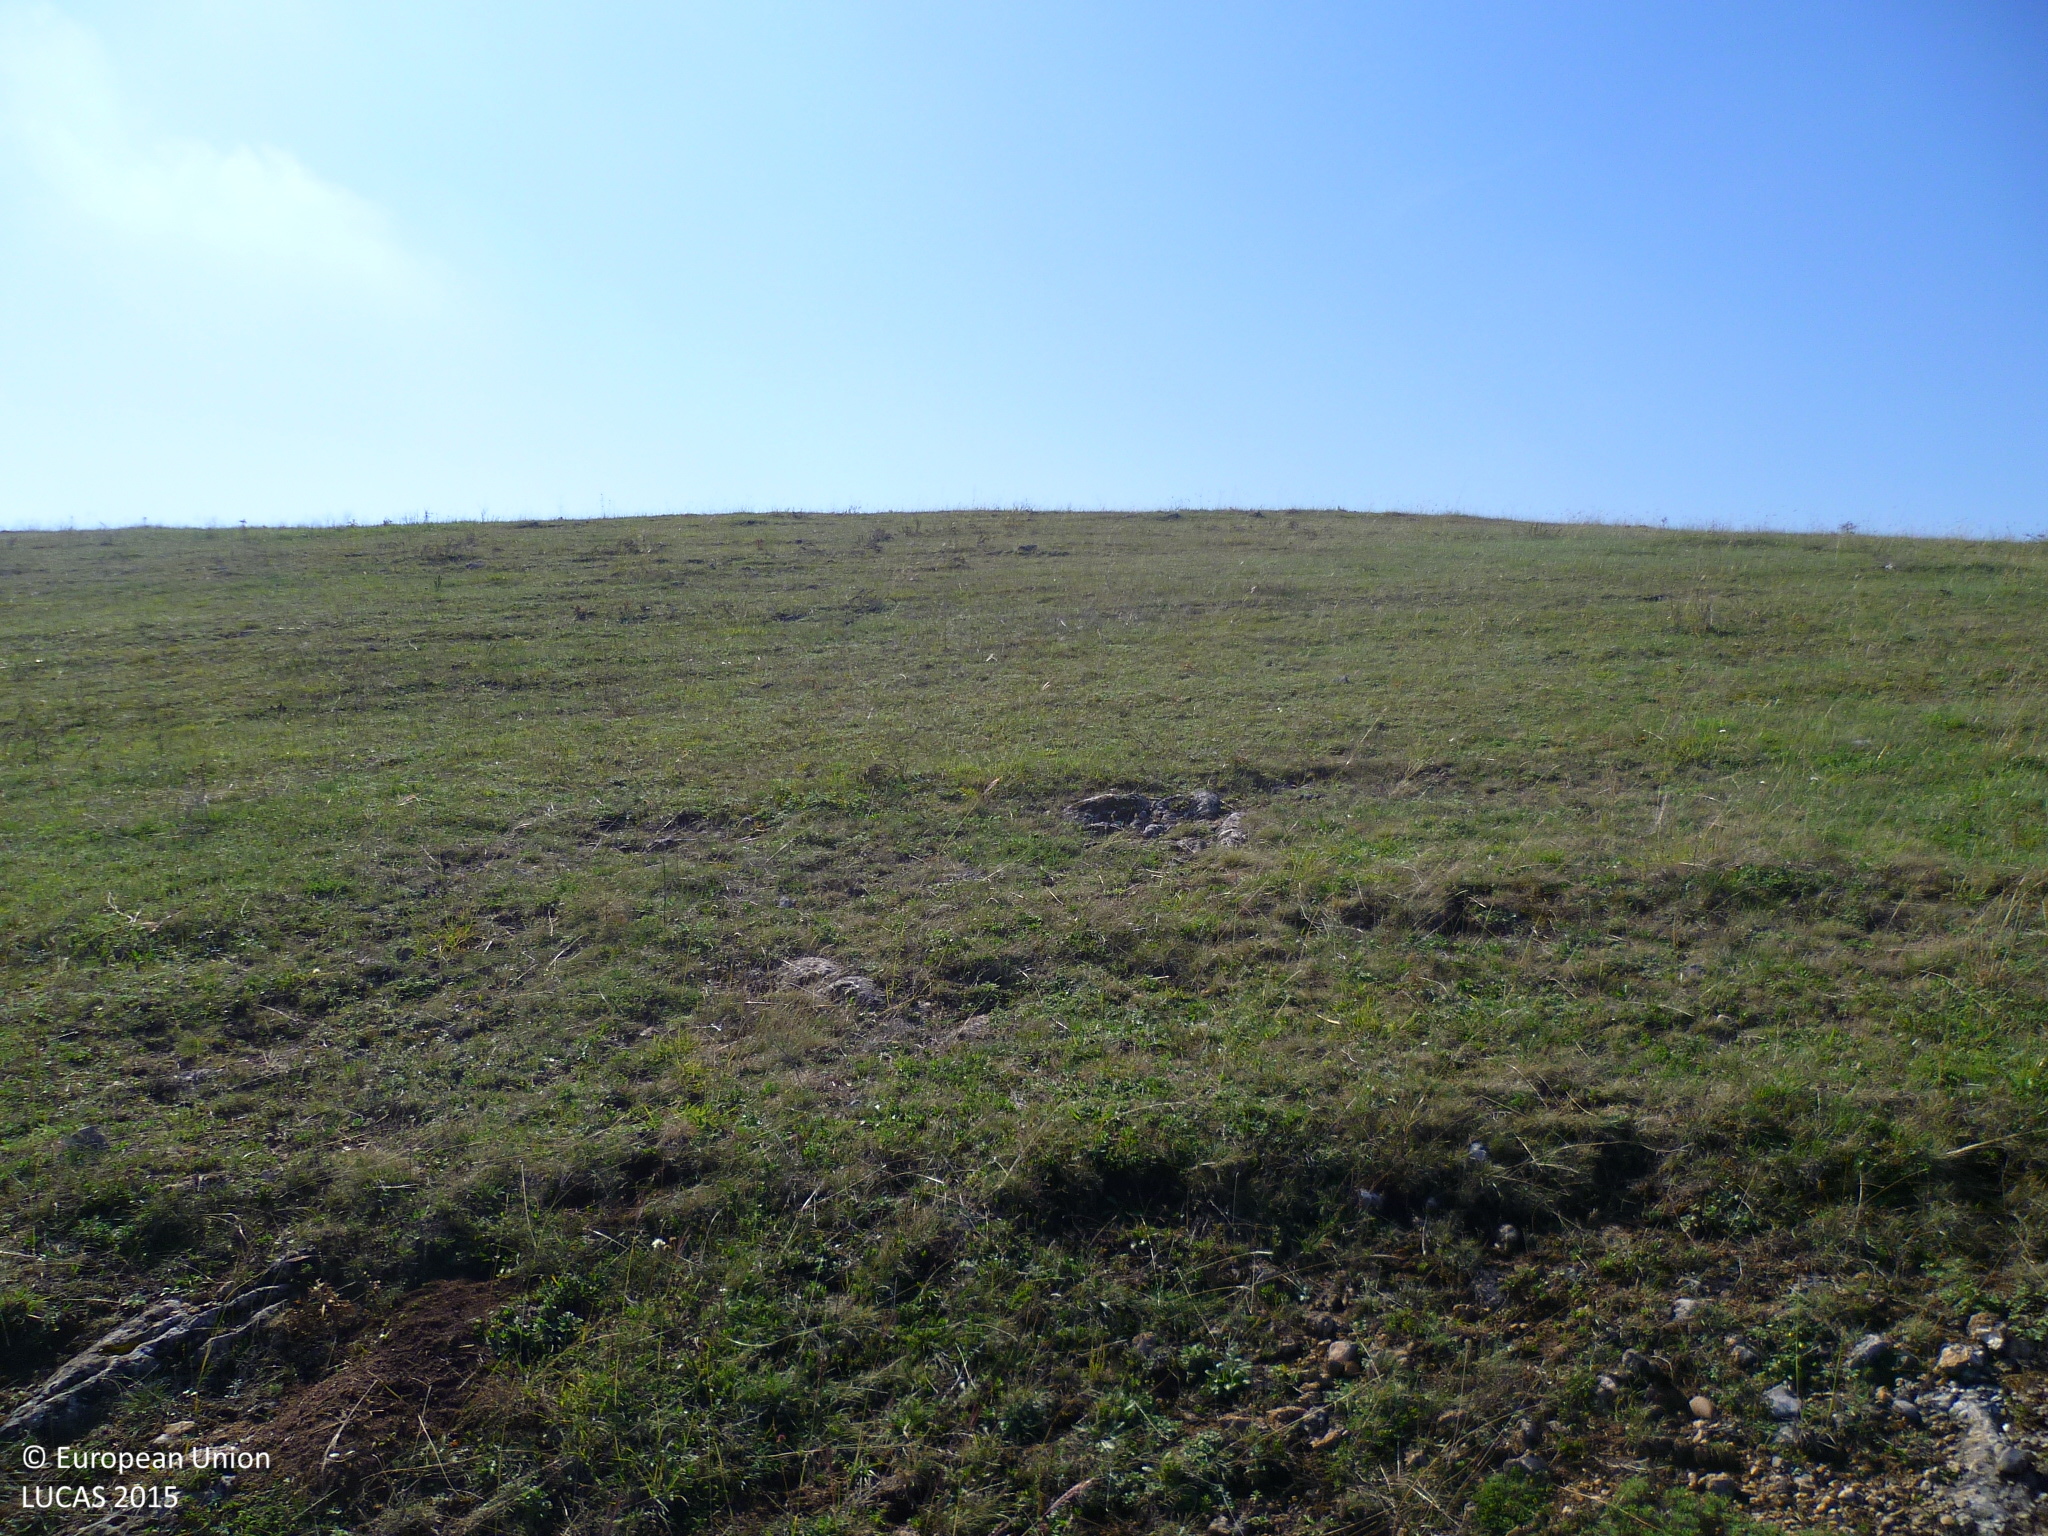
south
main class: Grassland
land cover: Grassland without tree/shrub cover
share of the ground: > 75 %
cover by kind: herbaceous plants 100 %
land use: Agriculture (excluding fallow land and kitchen gardens)
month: October
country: BG
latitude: 42.9256
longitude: 23.0068
